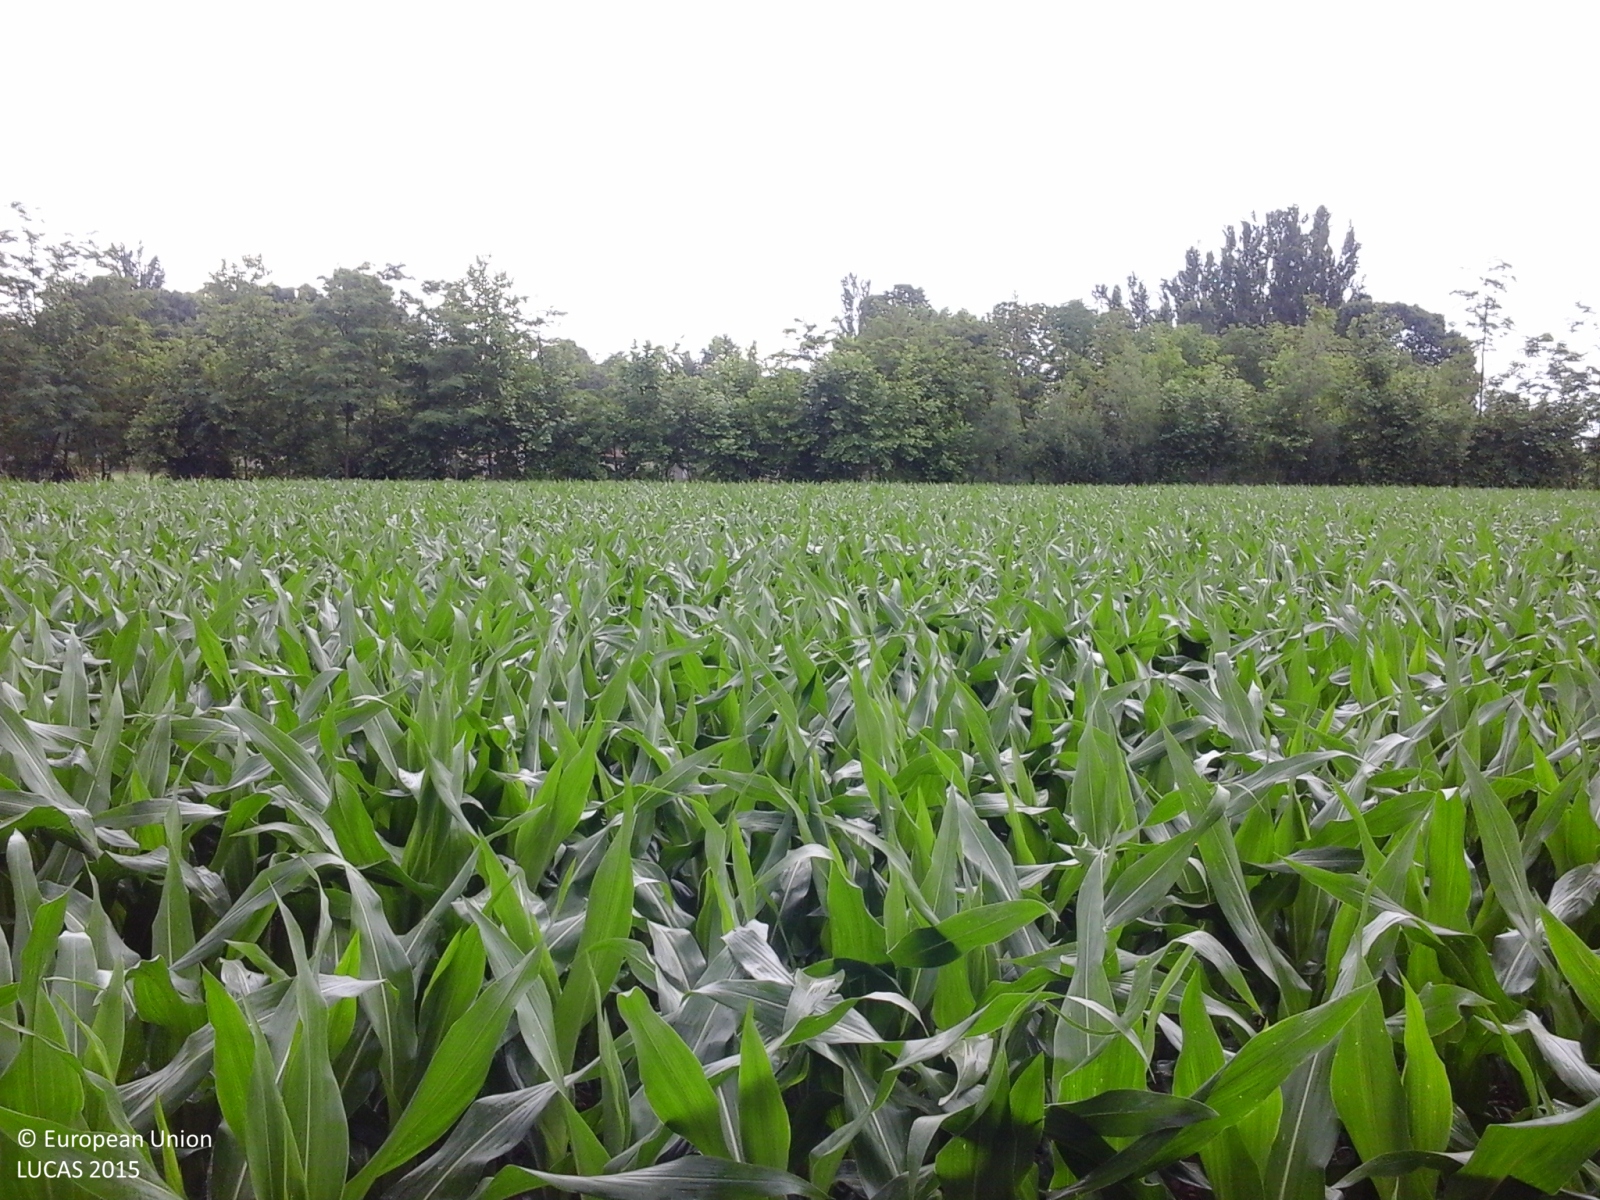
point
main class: Cropland
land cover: Maize
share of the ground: > 75 %
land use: Agriculture (excluding fallow land and kitchen gardens)
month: May
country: IT
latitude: 45.3962
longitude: 9.9107
